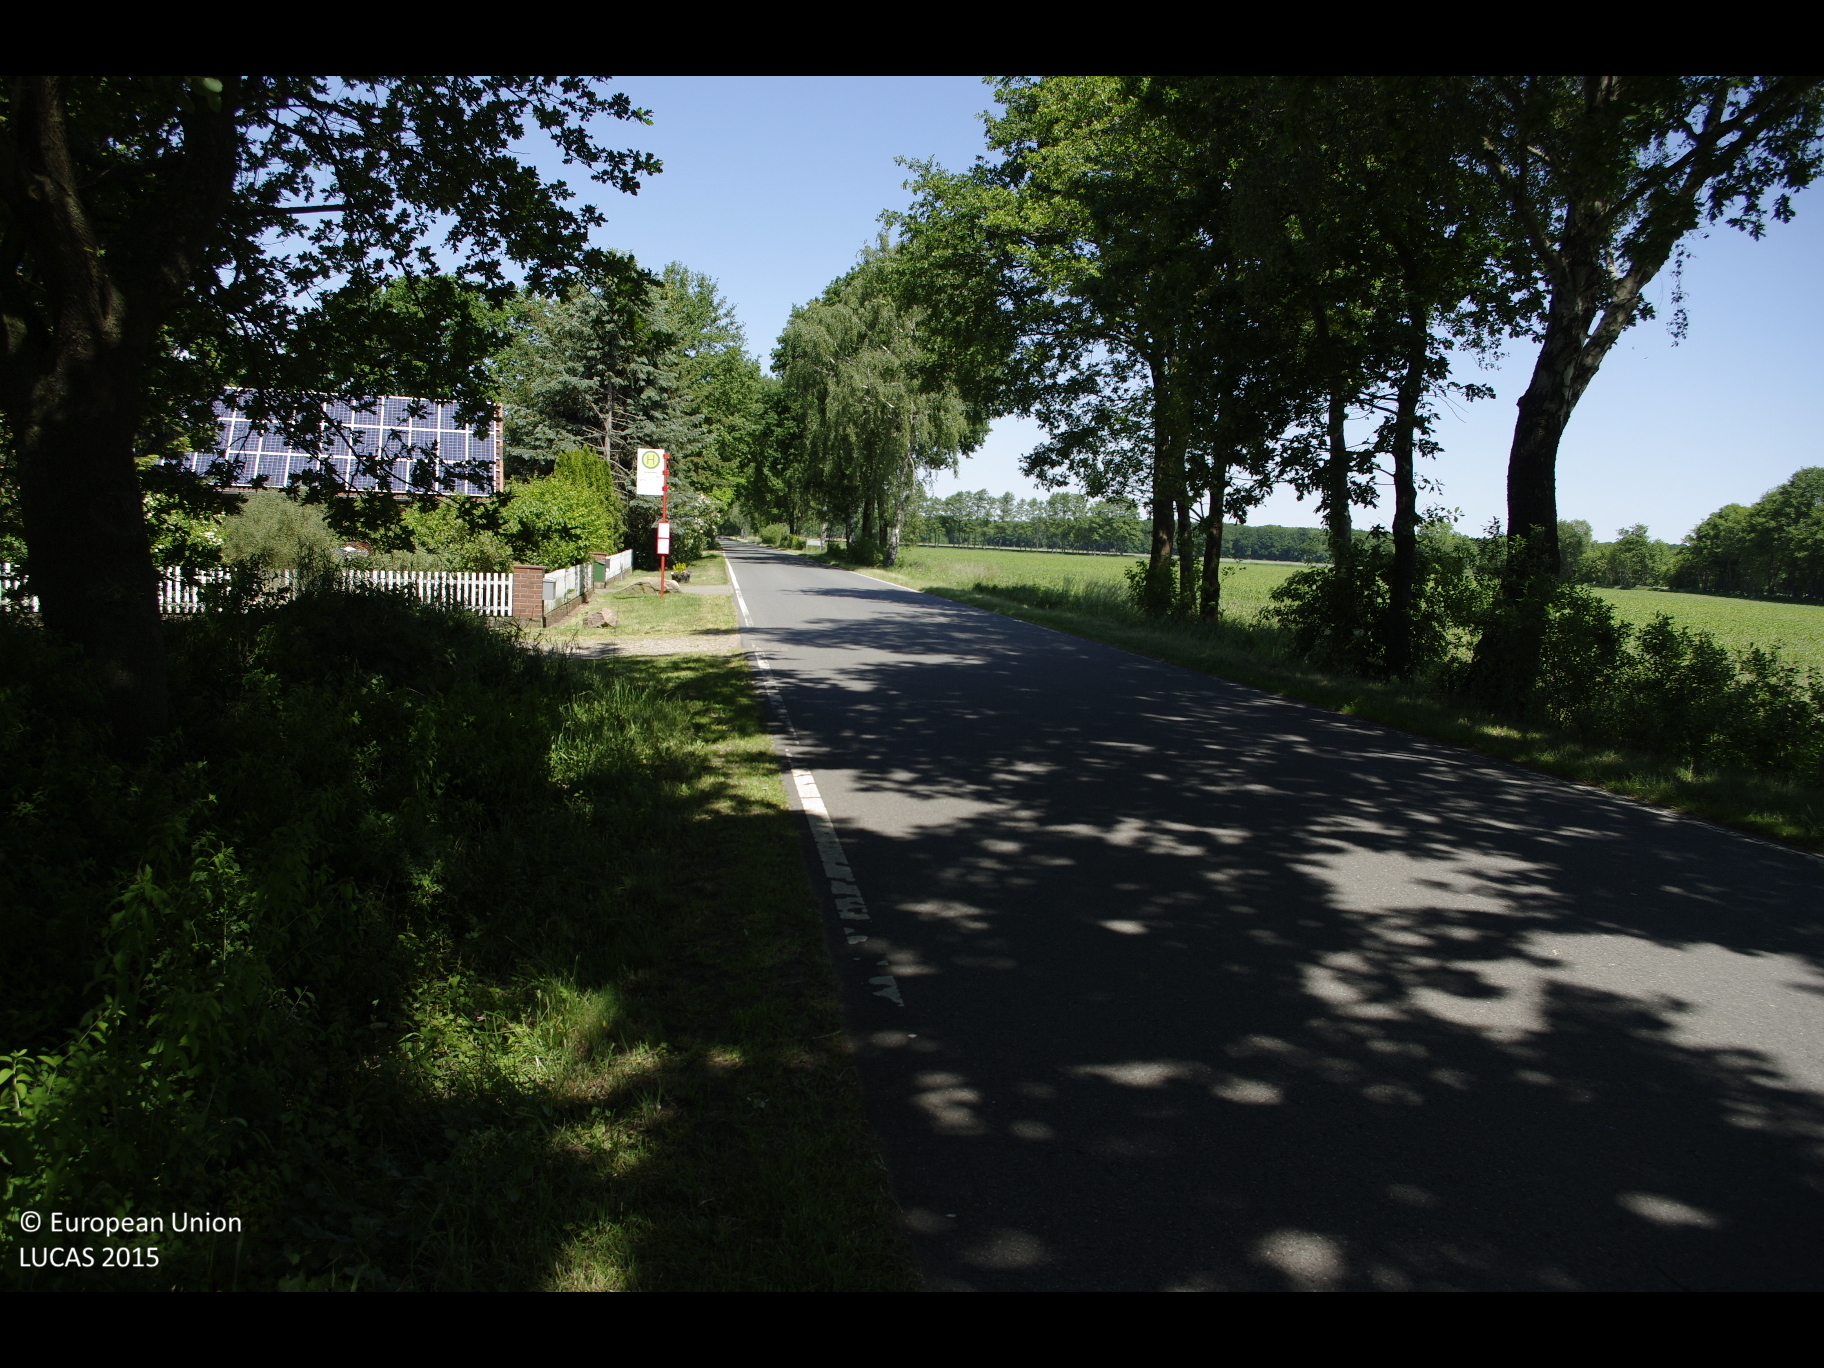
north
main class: Cropland
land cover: Maize
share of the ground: < 10 %
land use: Agriculture (excluding fallow land and kitchen gardens)
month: June
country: DE
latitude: 53.3105
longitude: 10.6151
